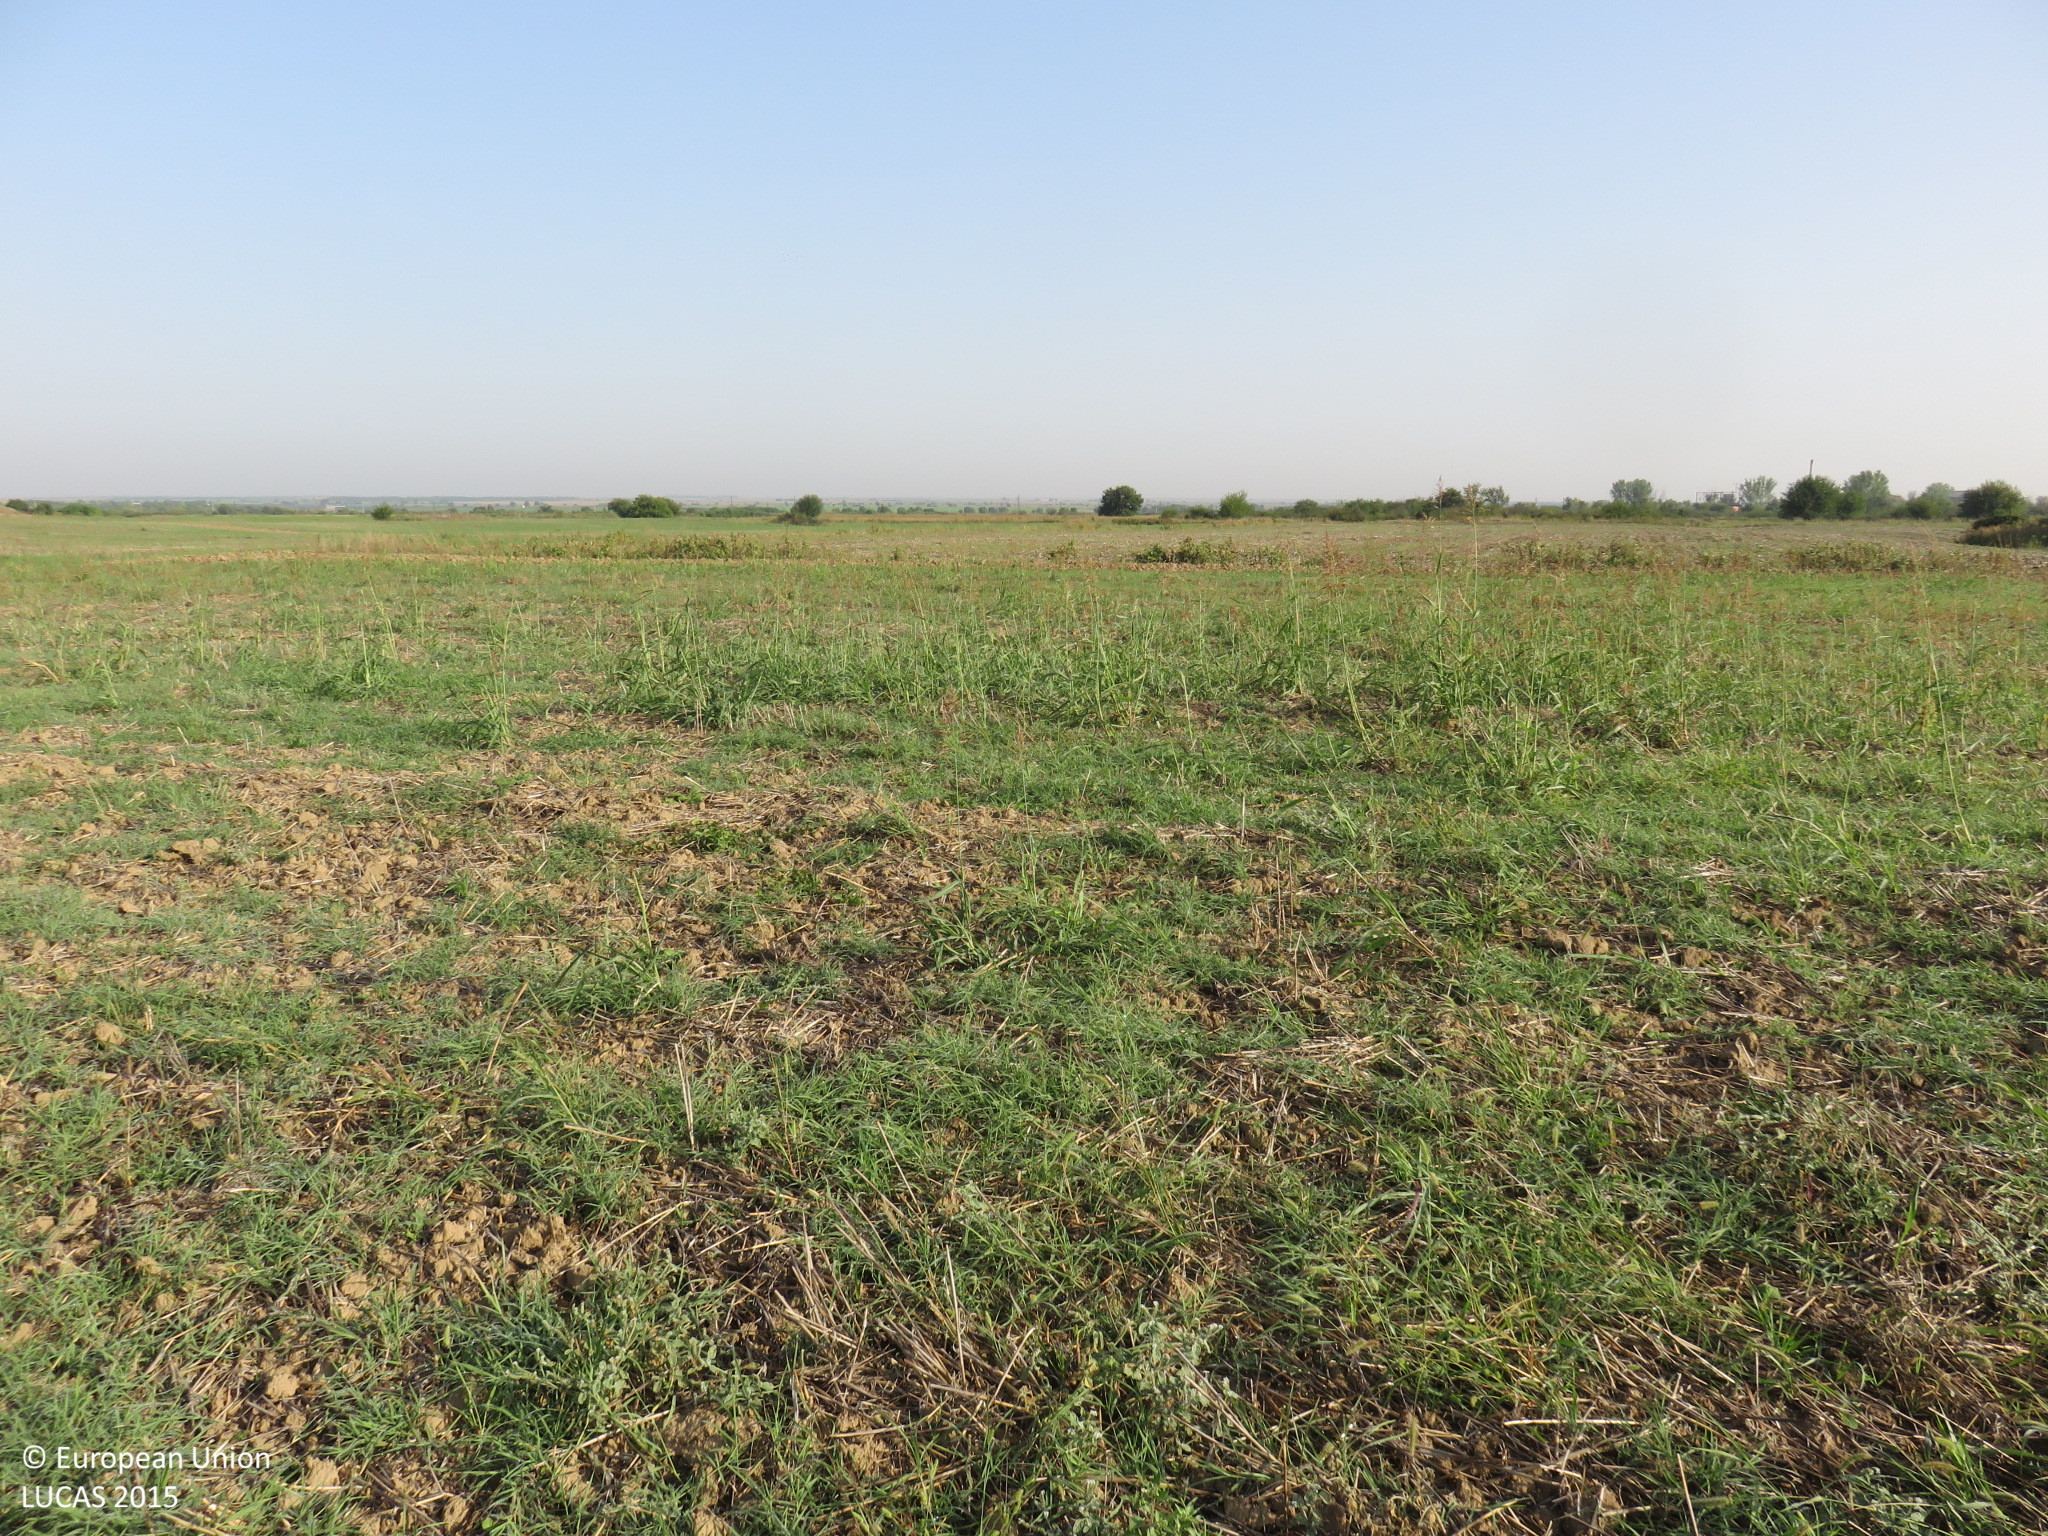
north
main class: Cropland
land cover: Common wheat
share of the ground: < 10 %
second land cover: Spontaneously vegetated surfaces
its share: 50 - 75 %
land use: Agriculture (excluding fallow land and kitchen gardens)
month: September
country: BG
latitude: 43.4988
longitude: 24.5697
